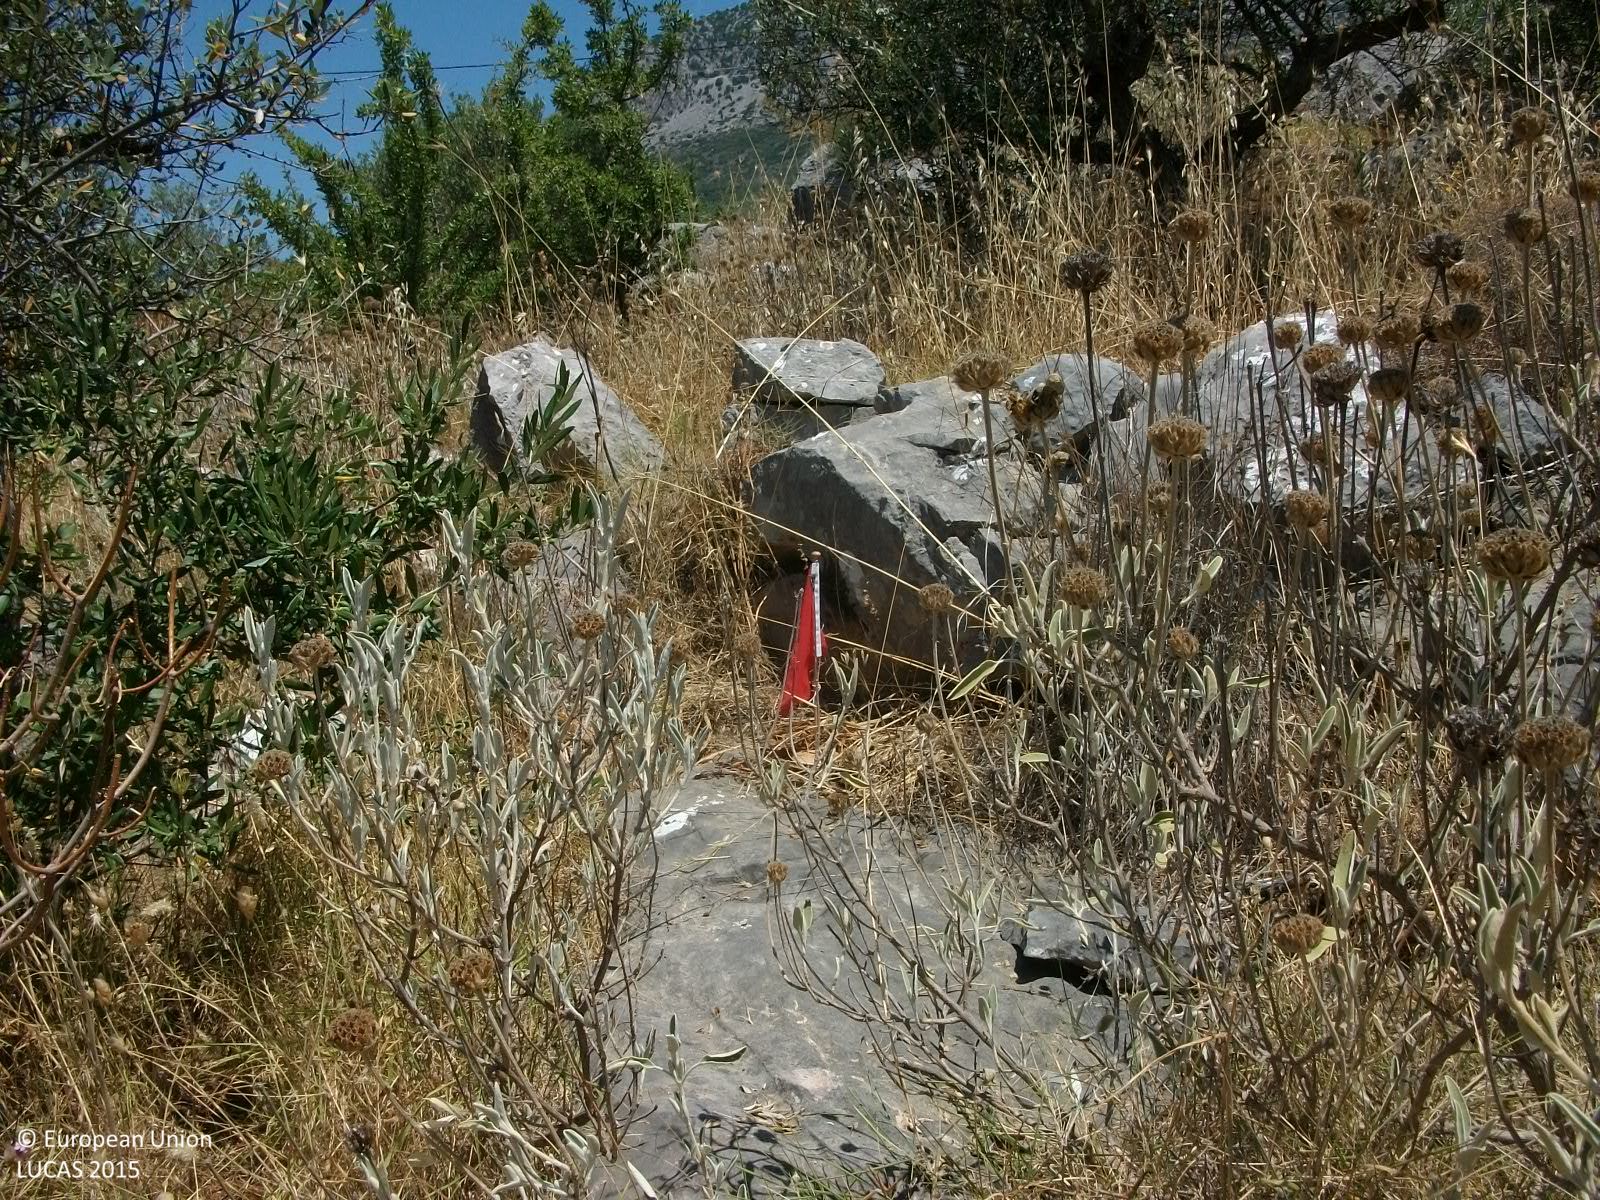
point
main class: Cropland
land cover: Olive groves
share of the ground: 25 - 50 %
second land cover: Spontaneously vegetated surfaces
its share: > 75 %
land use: Agriculture (excluding fallow land and kitchen gardens)
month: July
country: GR
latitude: 36.7170
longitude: 22.3663
